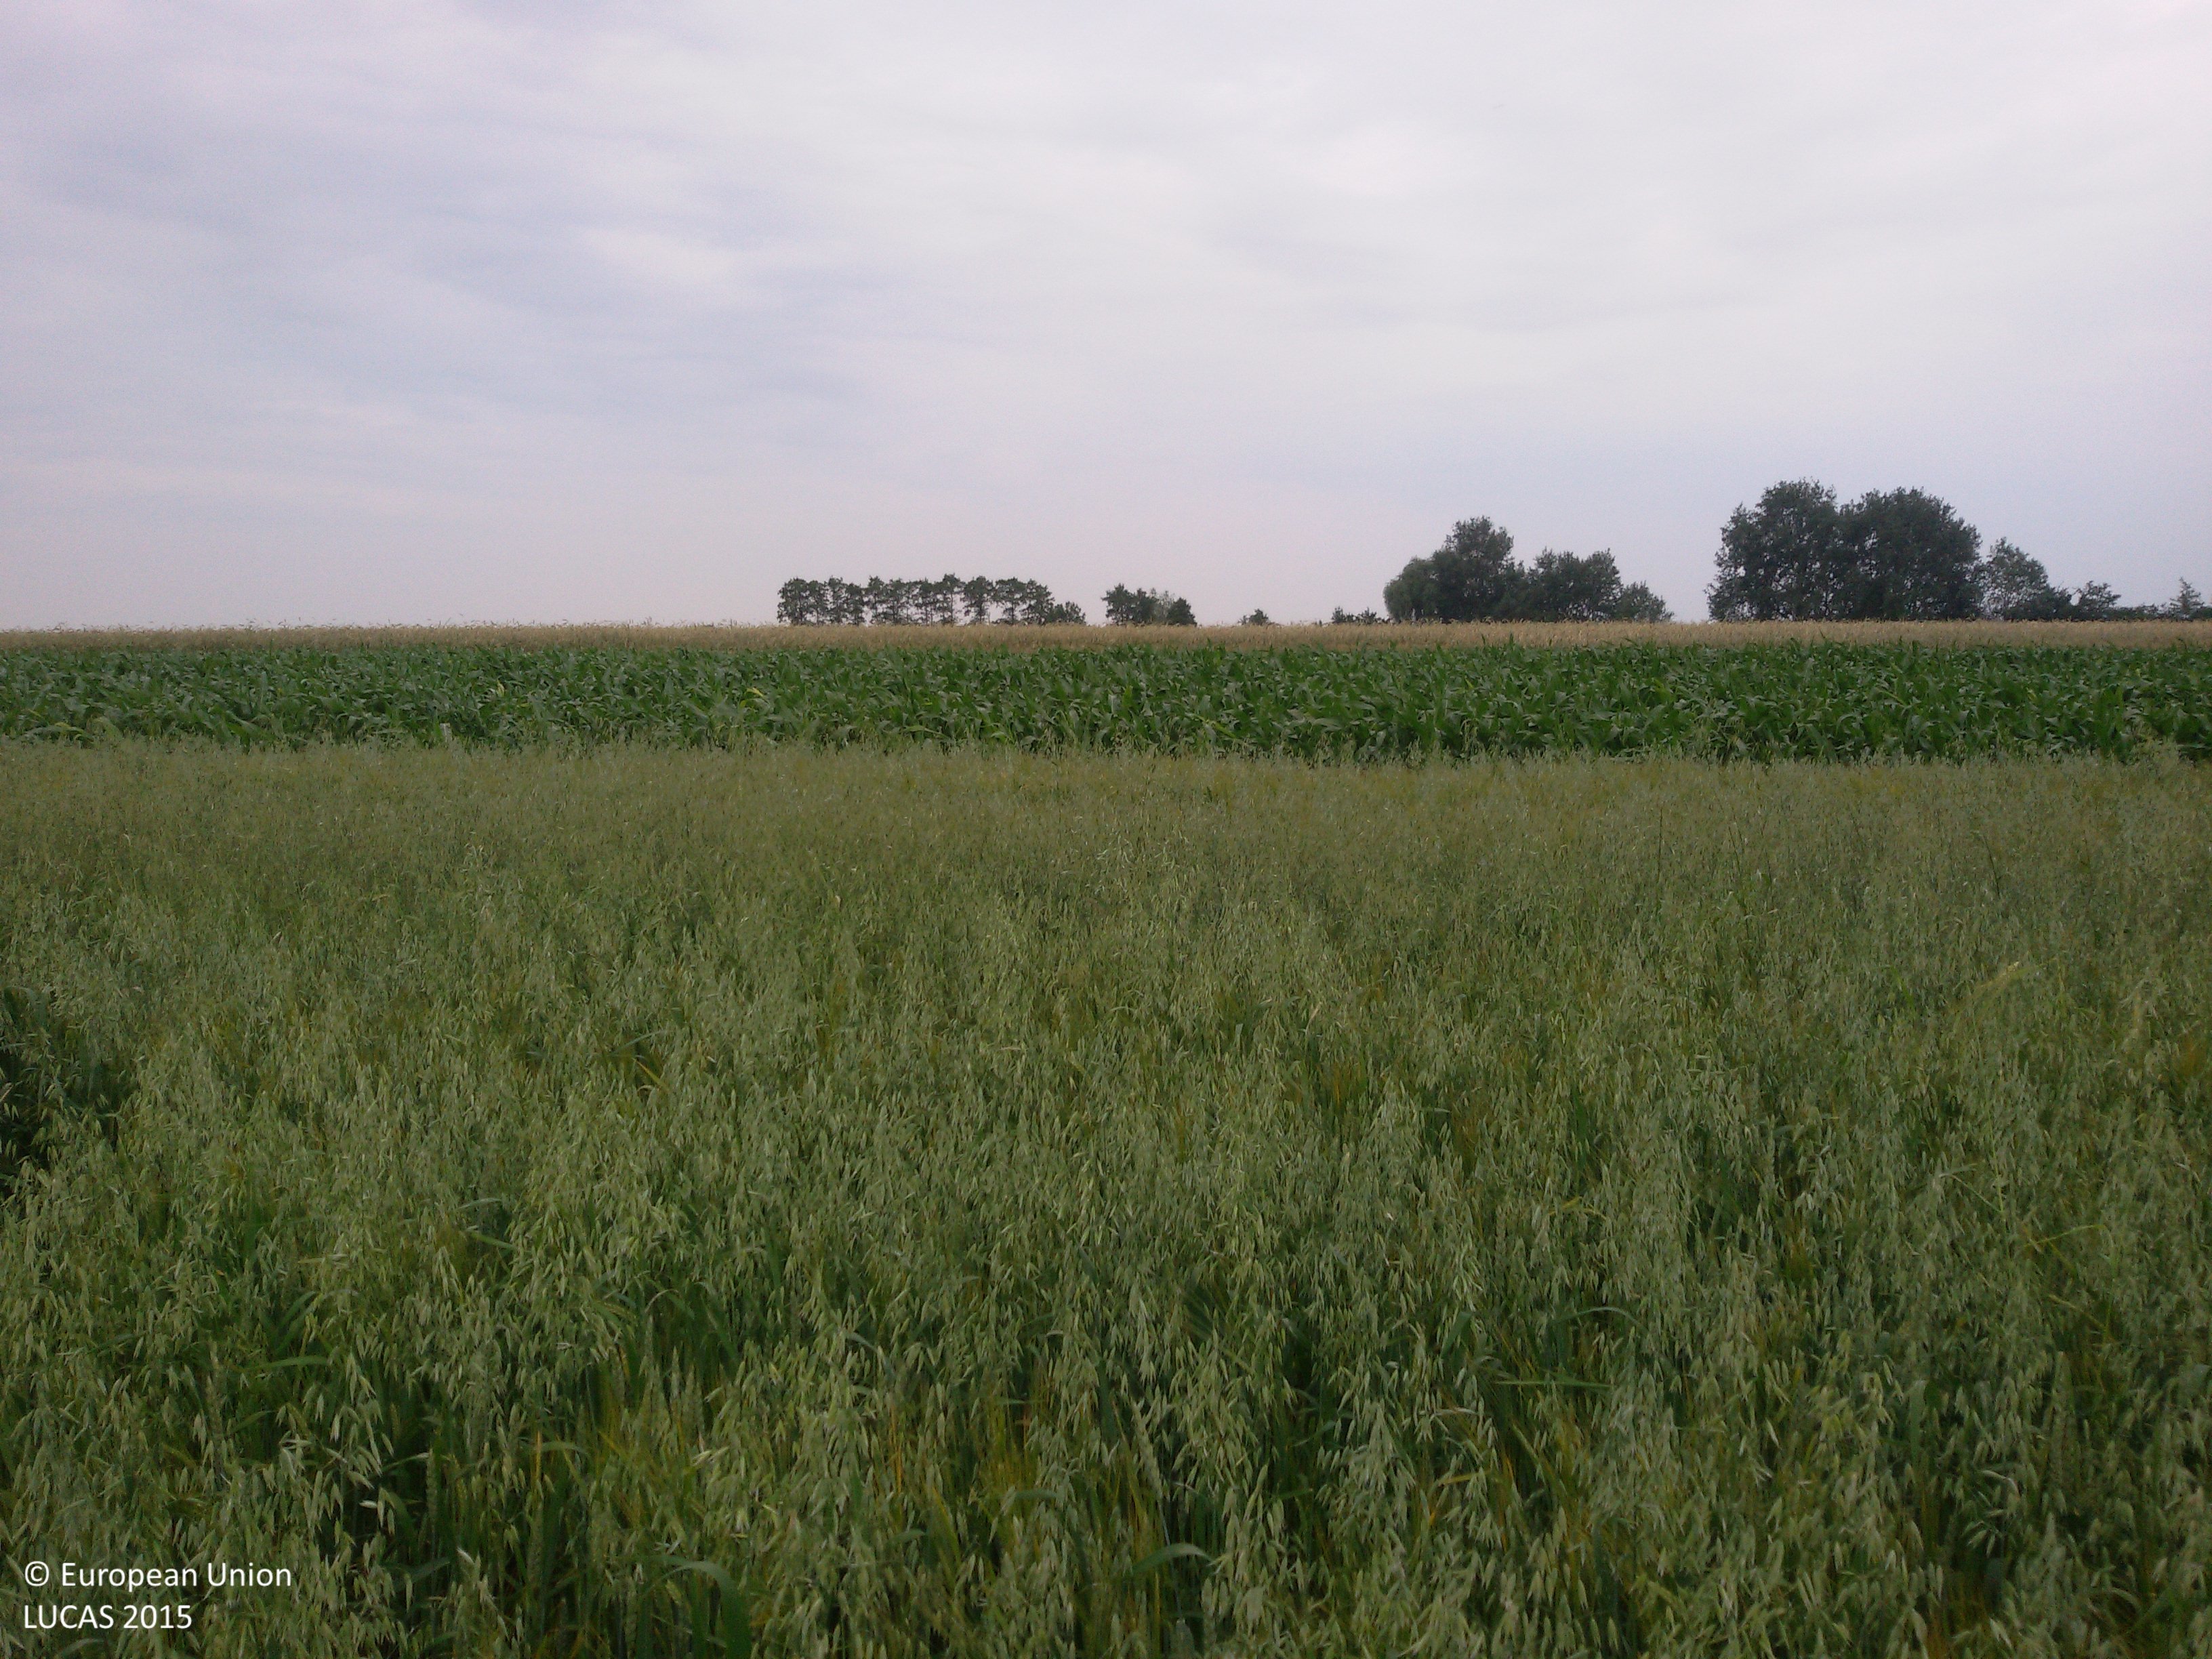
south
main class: Cropland
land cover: Oats
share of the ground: > 75 %
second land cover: Triticale
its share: > 75 %
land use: Agriculture (excluding fallow land and kitchen gardens)
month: June
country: PL
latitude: 52.1773
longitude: 19.9323
